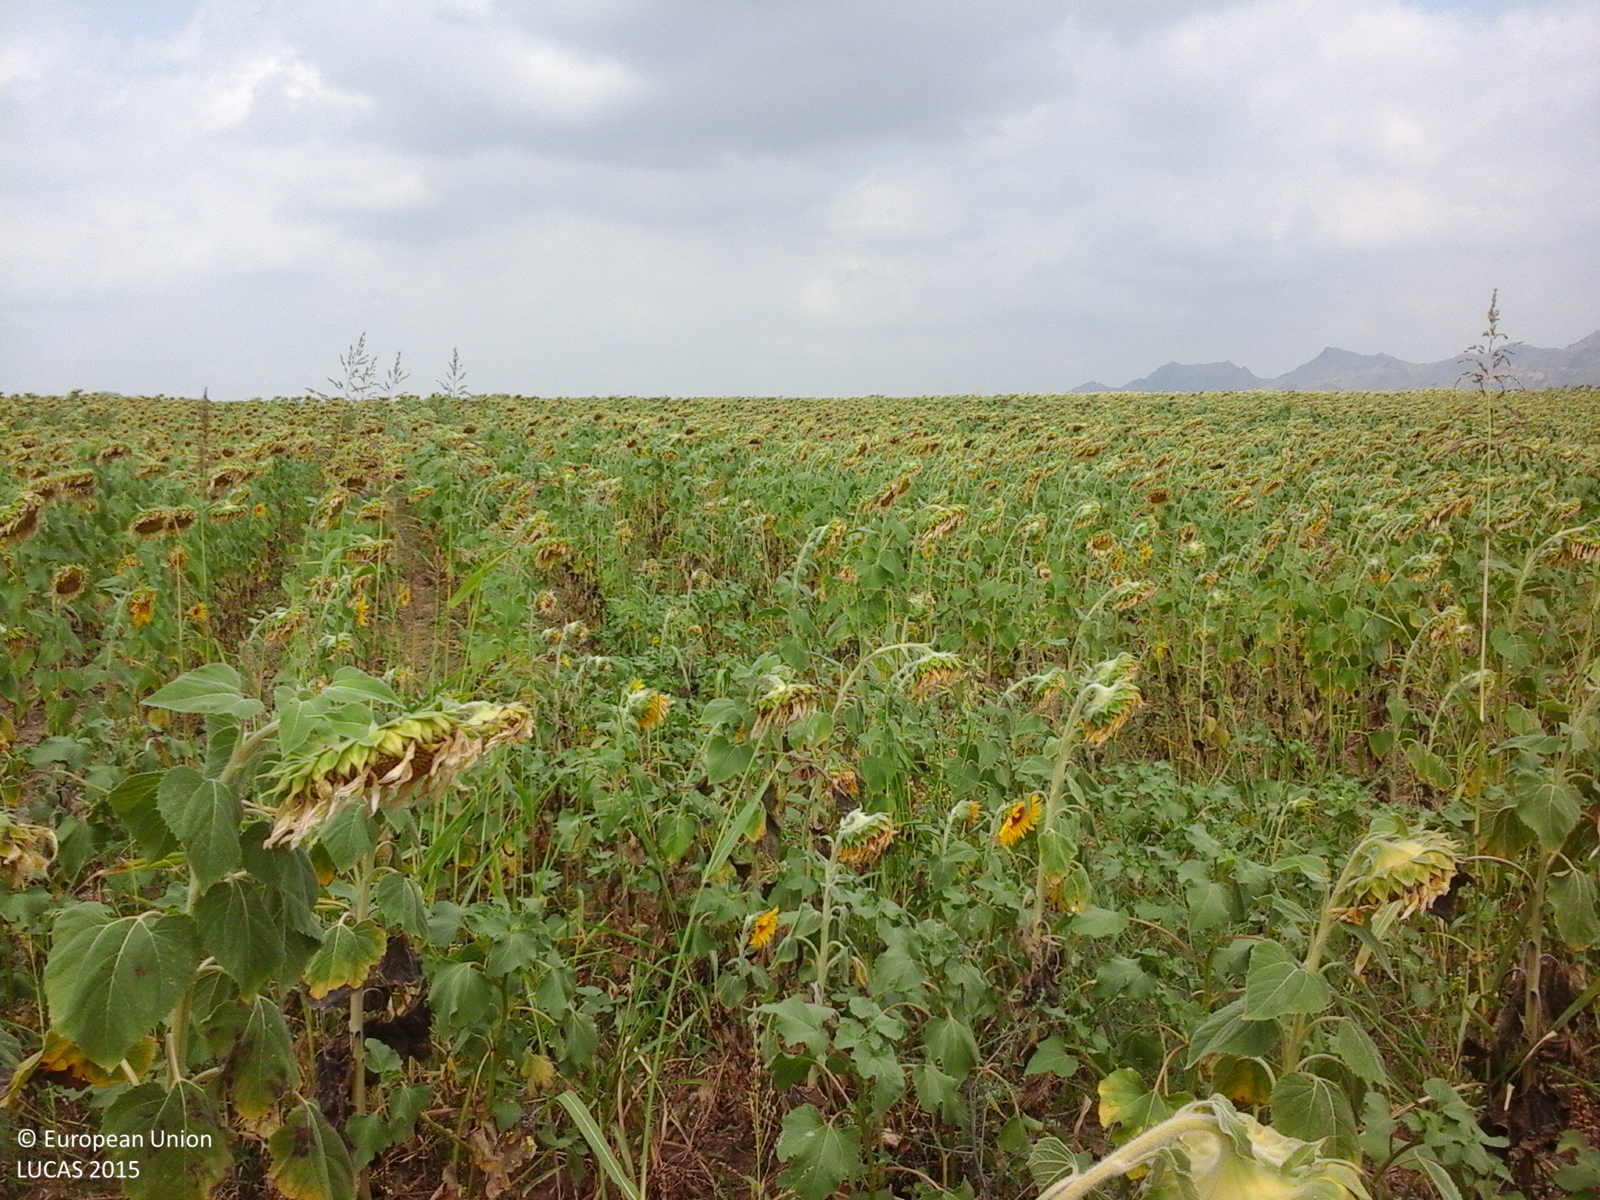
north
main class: Cropland
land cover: Sunflower
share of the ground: > 75 %
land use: Agriculture (excluding fallow land and kitchen gardens)
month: July
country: RO
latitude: 45.1995
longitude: 28.1847
